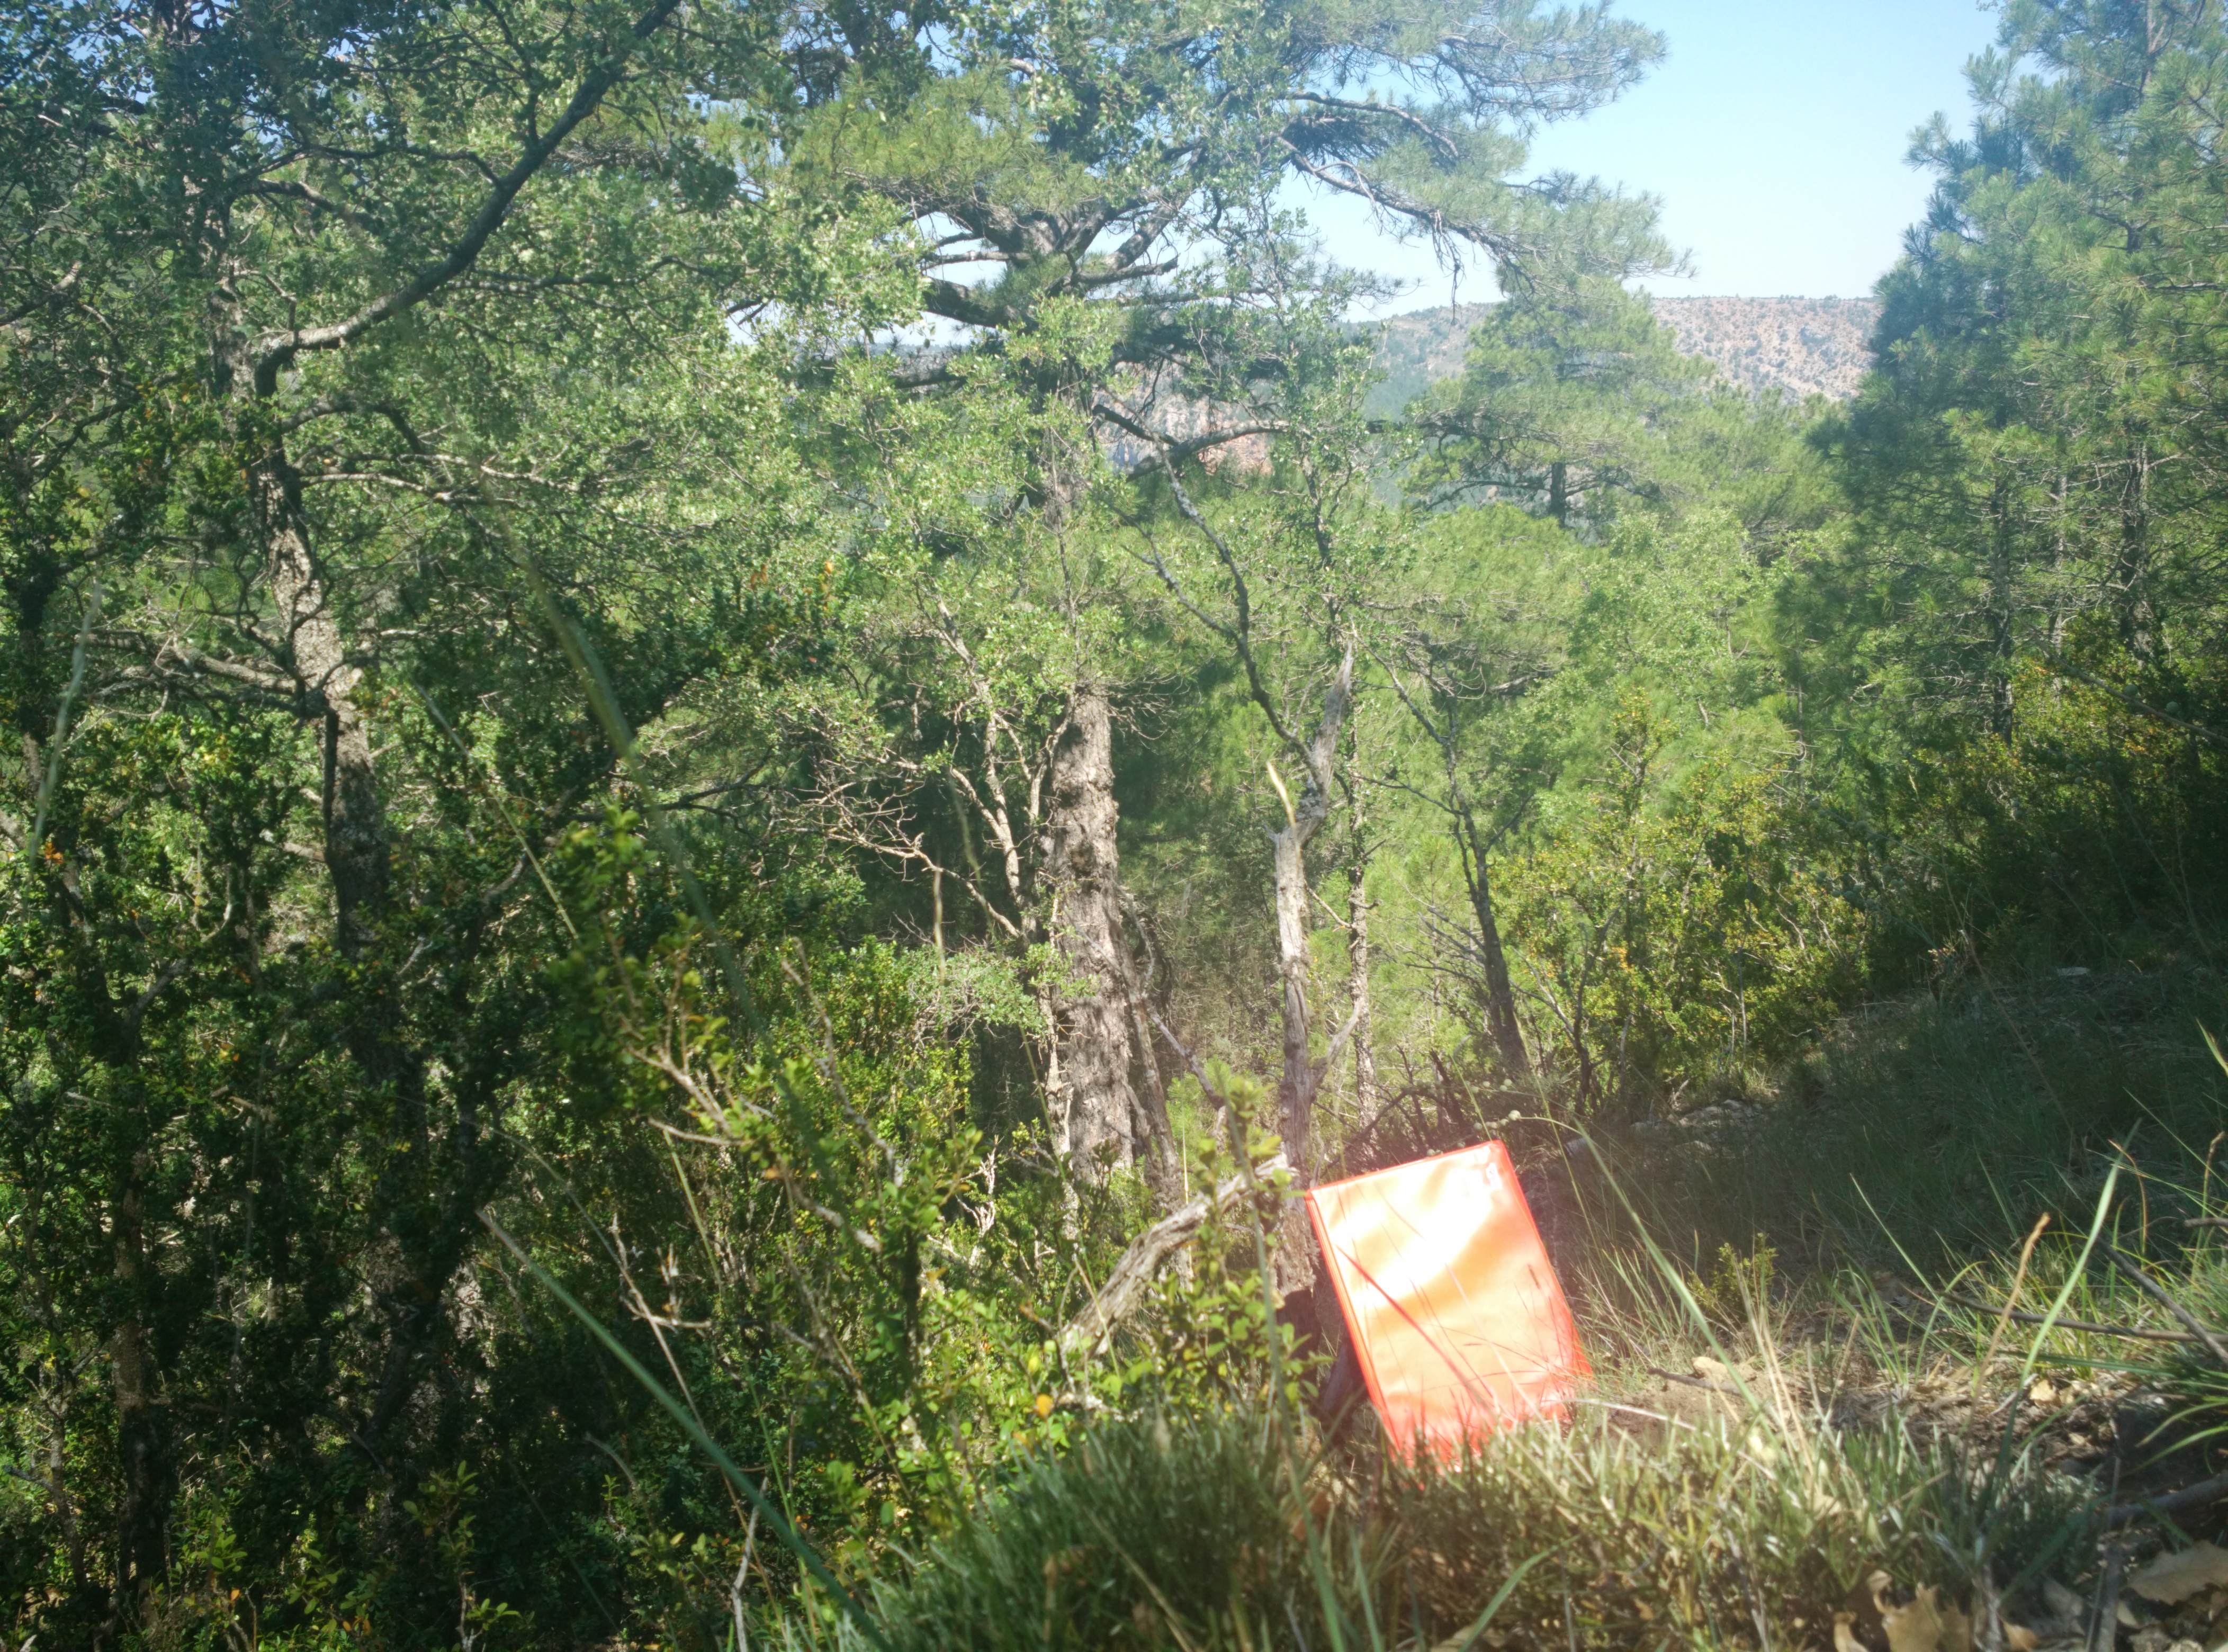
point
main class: Woodland
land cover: Pine dominated mixed woodland
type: coniferous forest of the mediterranean region
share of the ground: 50 - 75 %
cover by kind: coniferous forest trees 40 %, unconsolidated bare surface 25 %, broadleaved forest trees 20 %, shrubs 10 %, herbaceous plants 5 %
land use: Semi-natural and natural areas not in use
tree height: > 5 m
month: June
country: ES
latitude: 40.6629
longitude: -1.9796
